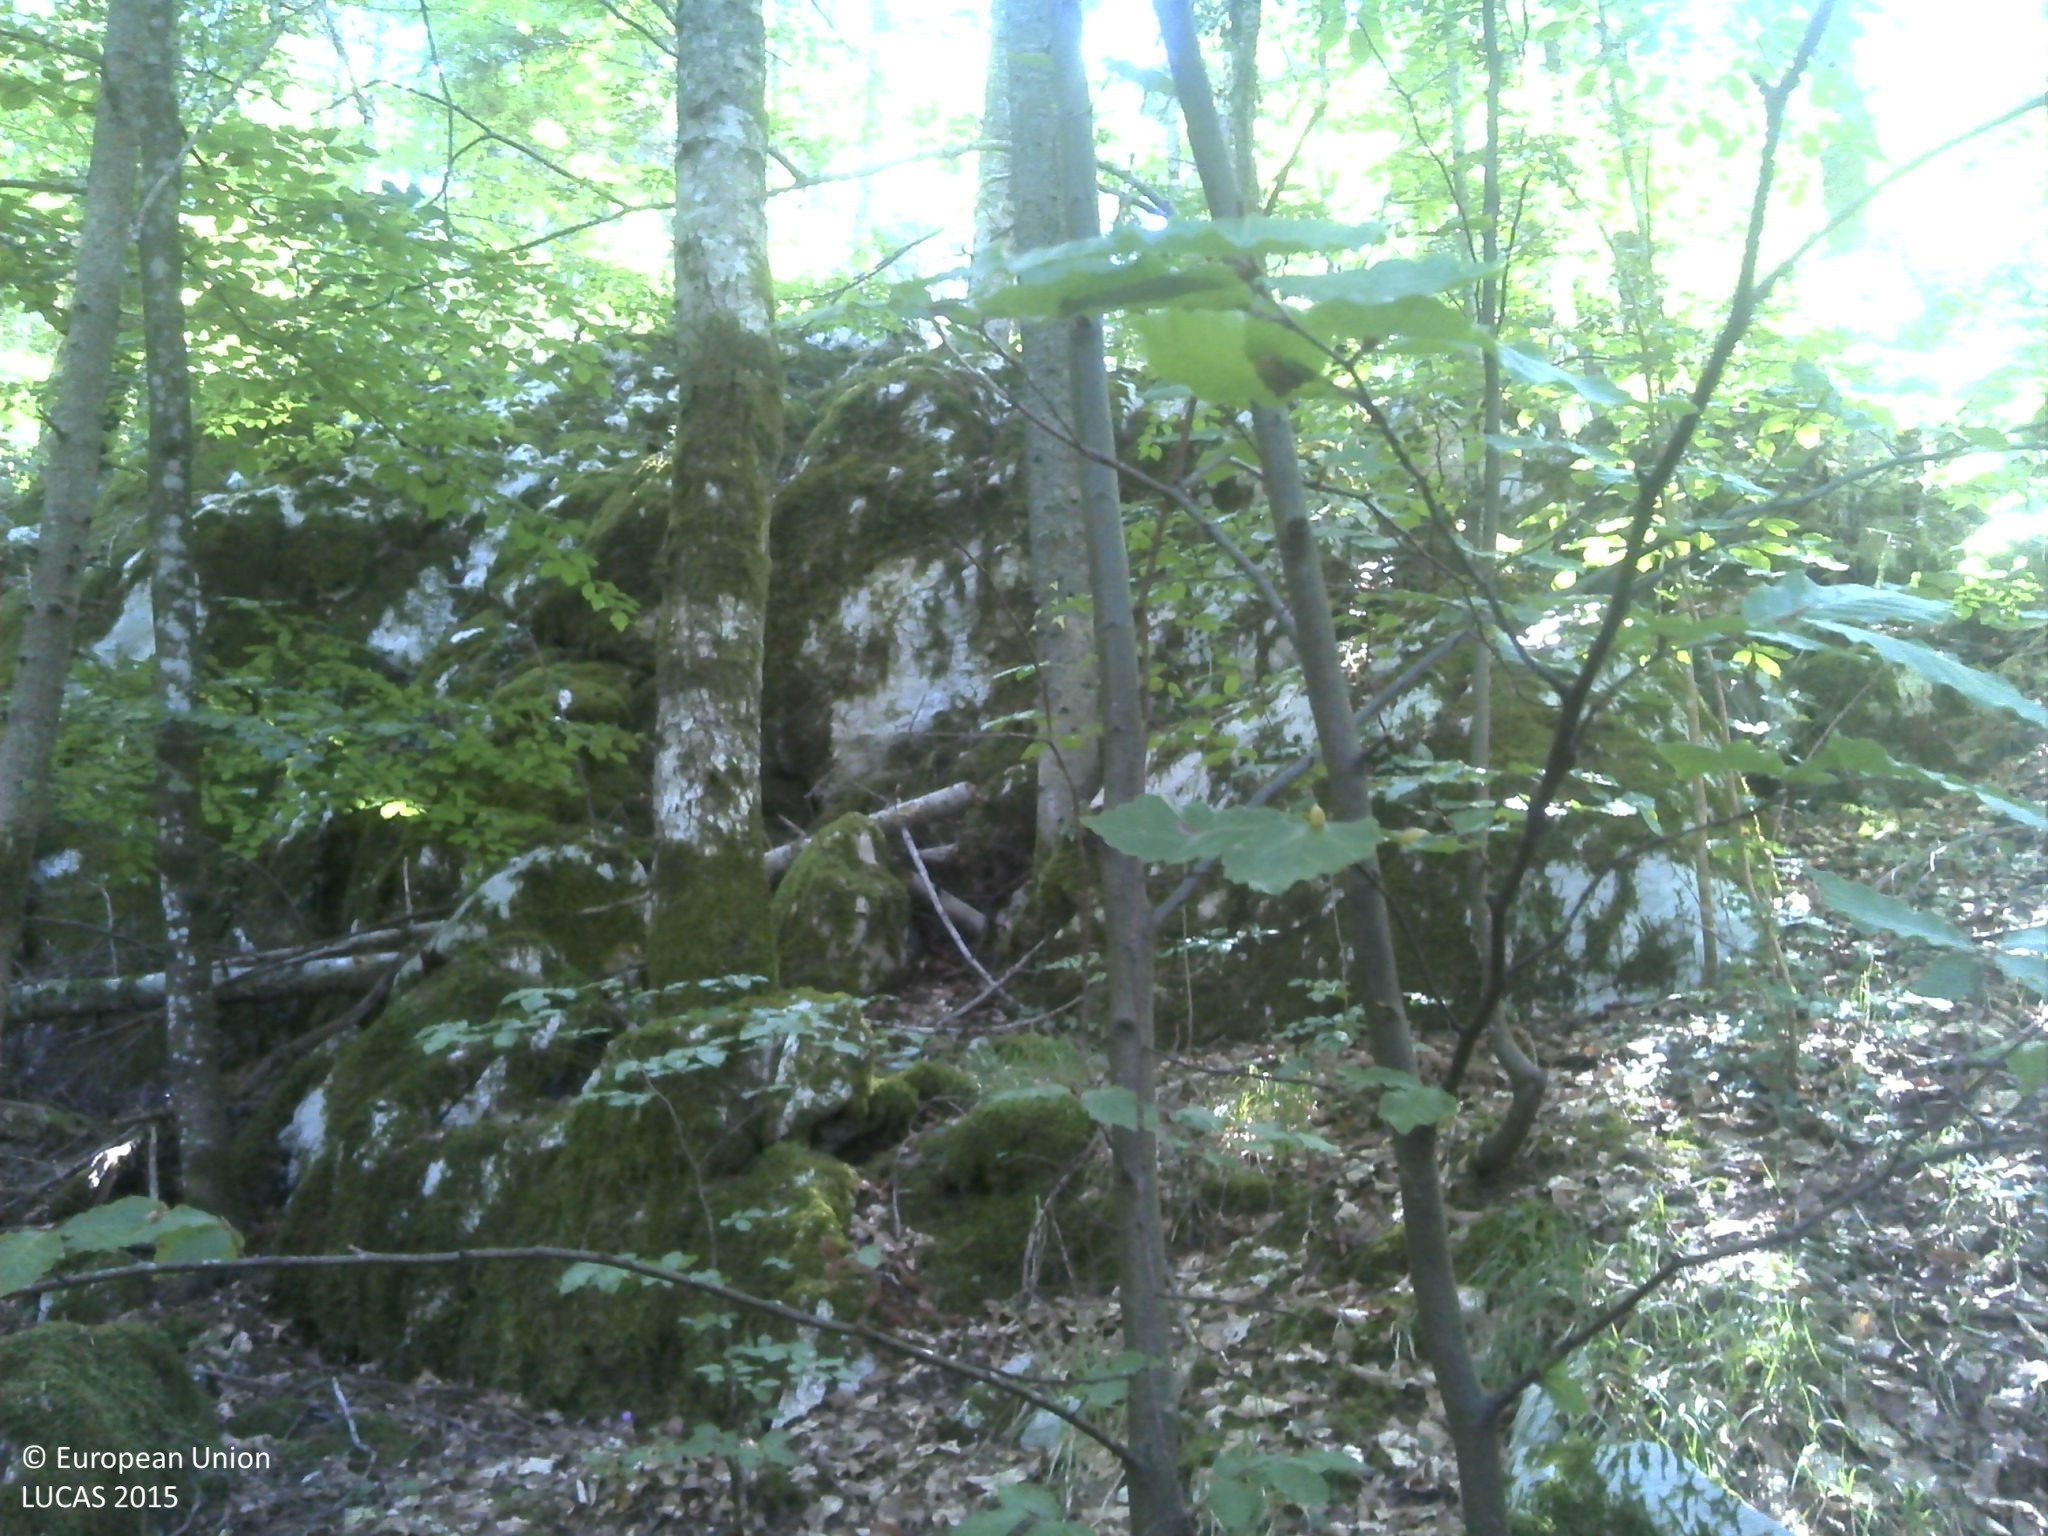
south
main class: Woodland
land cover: Other mixed woodland
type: beech forest
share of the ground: > 75 %
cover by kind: broadleaved forest trees 55 %, coniferous forest trees 30 %, lichens and mosses 5 %, consolidated bare surface 5 %, unconsolidated bare surface 5 %
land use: Forestry
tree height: > 5 m
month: August
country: HR
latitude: 44.7052
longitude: 15.2568
